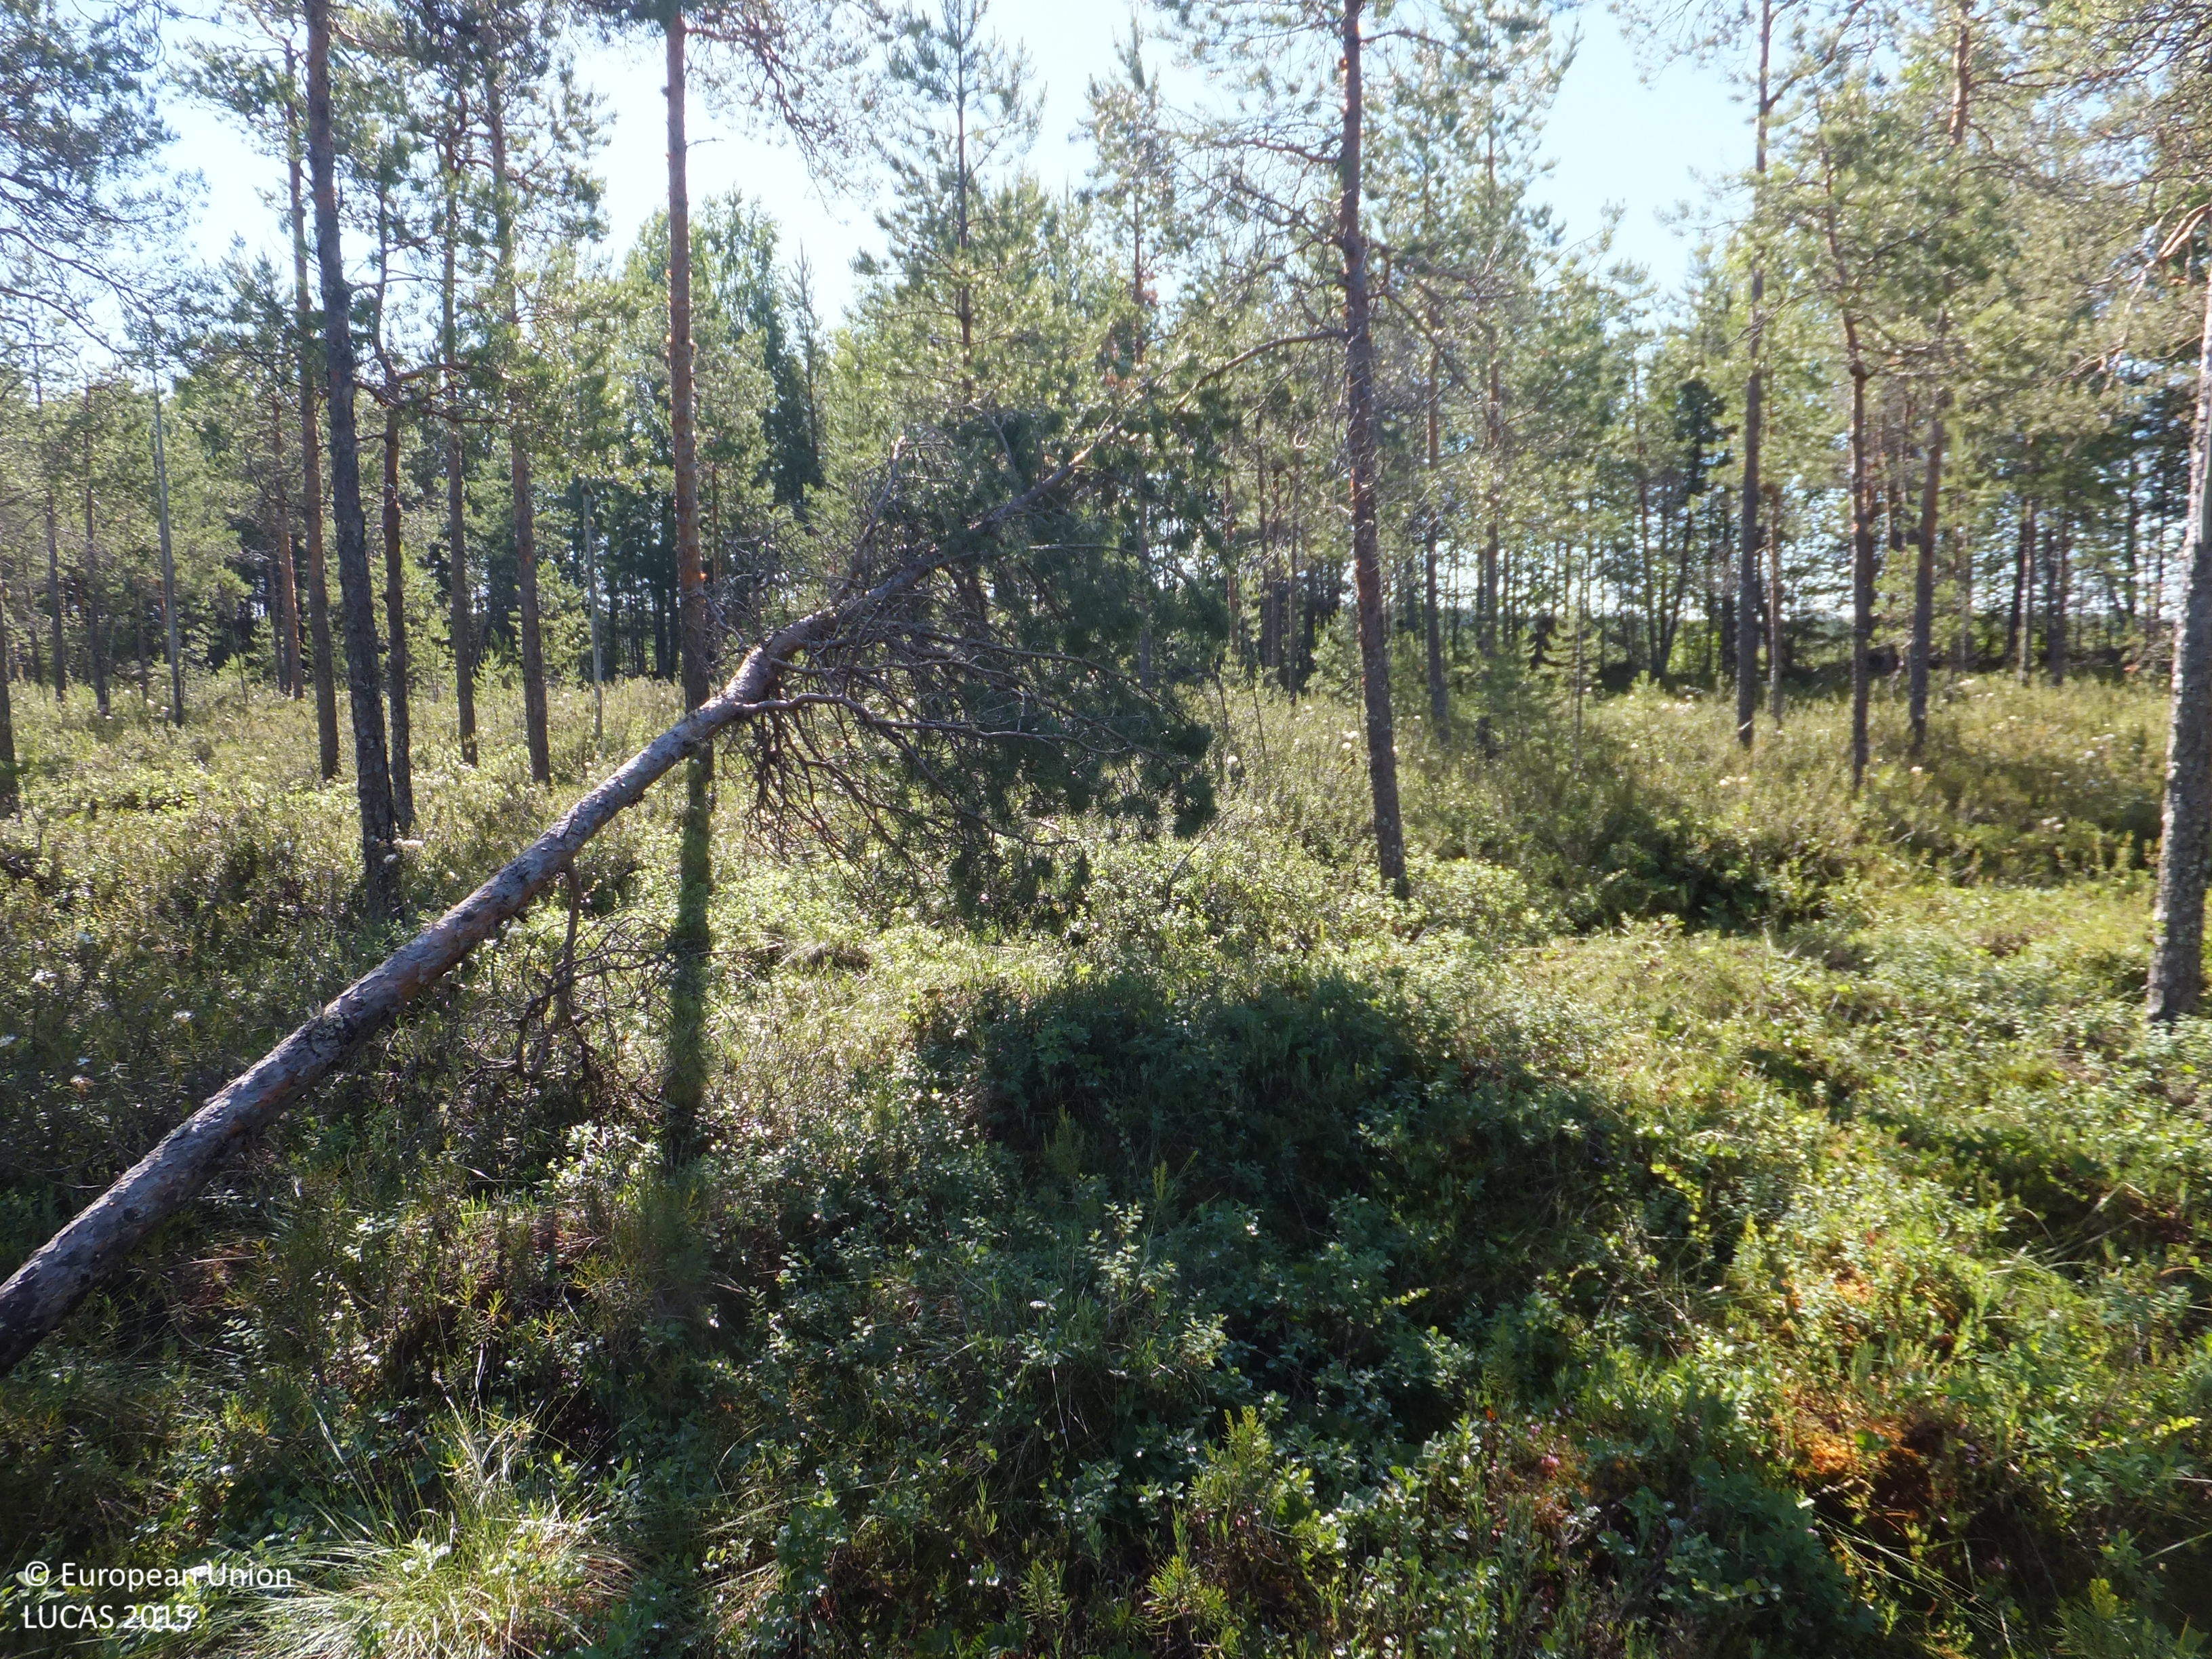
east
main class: Woodland
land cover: Pine dominated coniferous woodland
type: mire and swamp forests
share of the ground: 50 - 75 %
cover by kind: coniferous forest trees 50 %, shrubs 40 %, lichens and mosses 10 %
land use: Forestry
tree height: > 5 m
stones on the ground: < 10 %
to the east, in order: Pine dominated coniferous woodland; Pine dominated mixed woodland; Ditches and canals; Peatbogs; Ditches and canals; Spontaneously vegetated surfaces; Peatbogs; Ditches and canals; Peatbogs; Ditches and canals; Peatbogs; Ditches and canals; Peatbogs
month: July
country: FI
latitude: 63.1708
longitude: 23.9548
